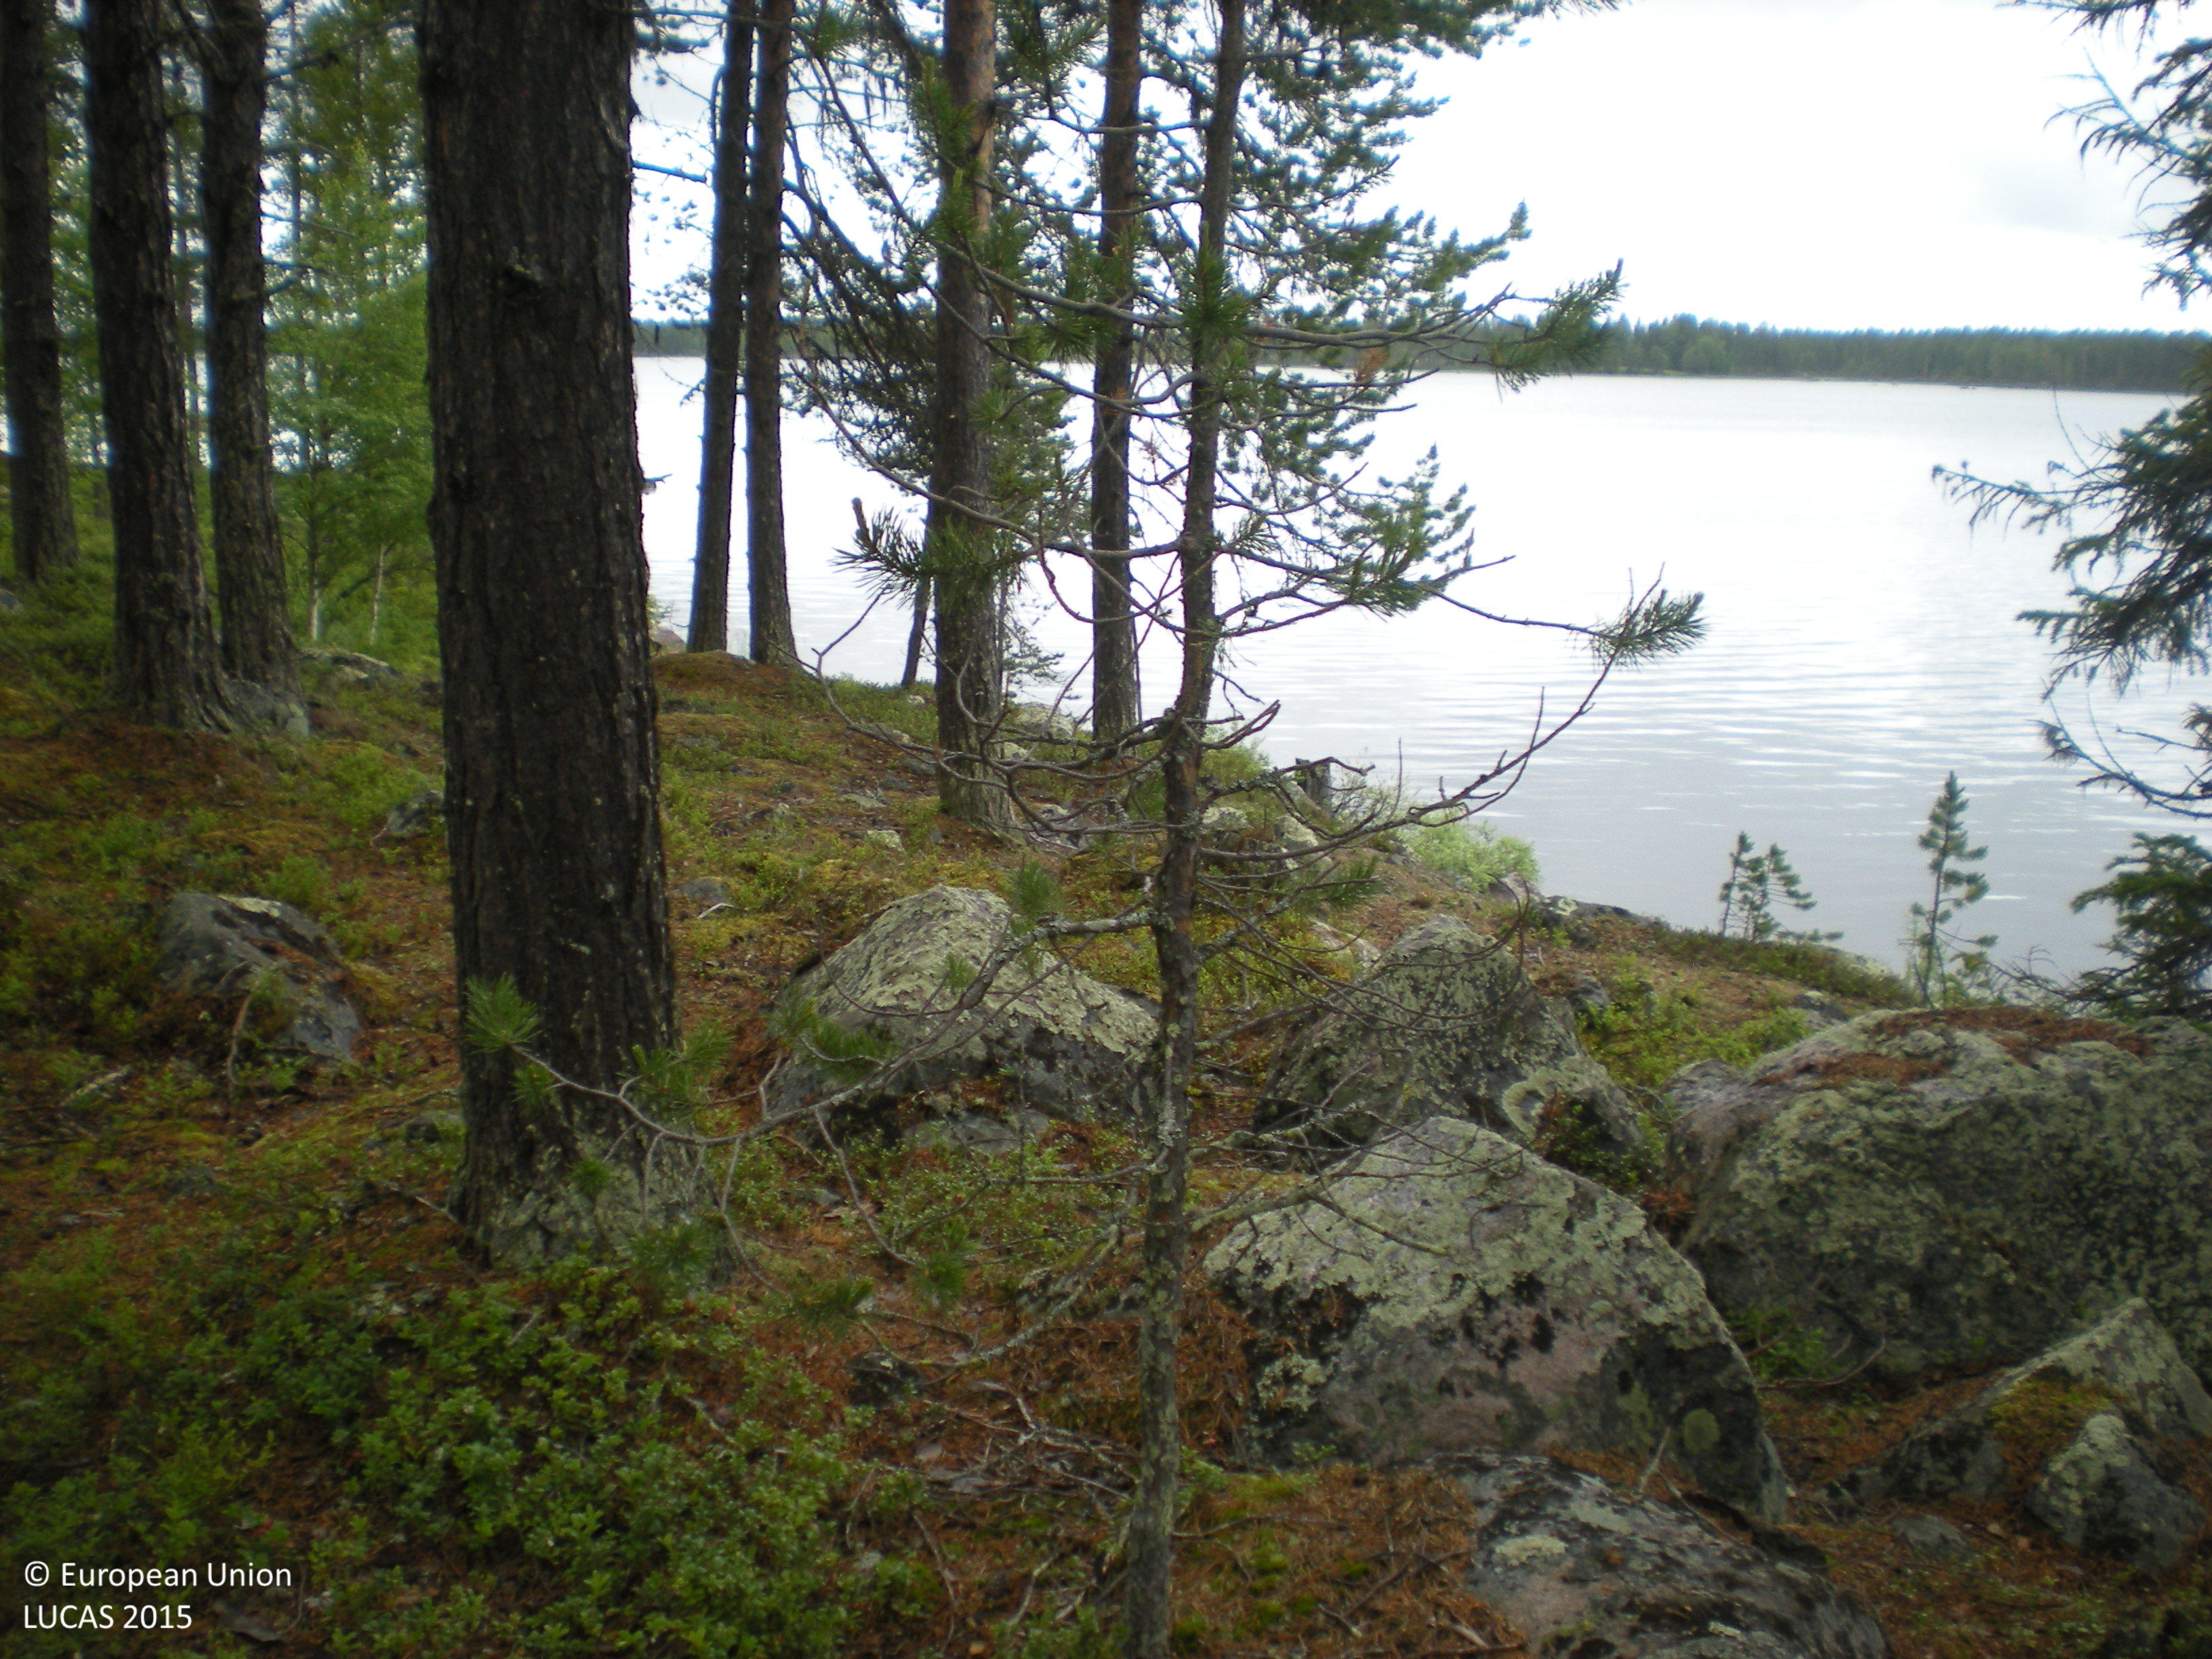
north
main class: Woodland
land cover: Pine dominated coniferous woodland
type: boreal forest
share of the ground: 50 - 75 %
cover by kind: coniferous forest trees 60 %, shrubs 30 %, lichens and mosses 10 %
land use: Forestry
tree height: > 5 m
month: July
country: SE
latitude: 65.8808
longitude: 17.7422
